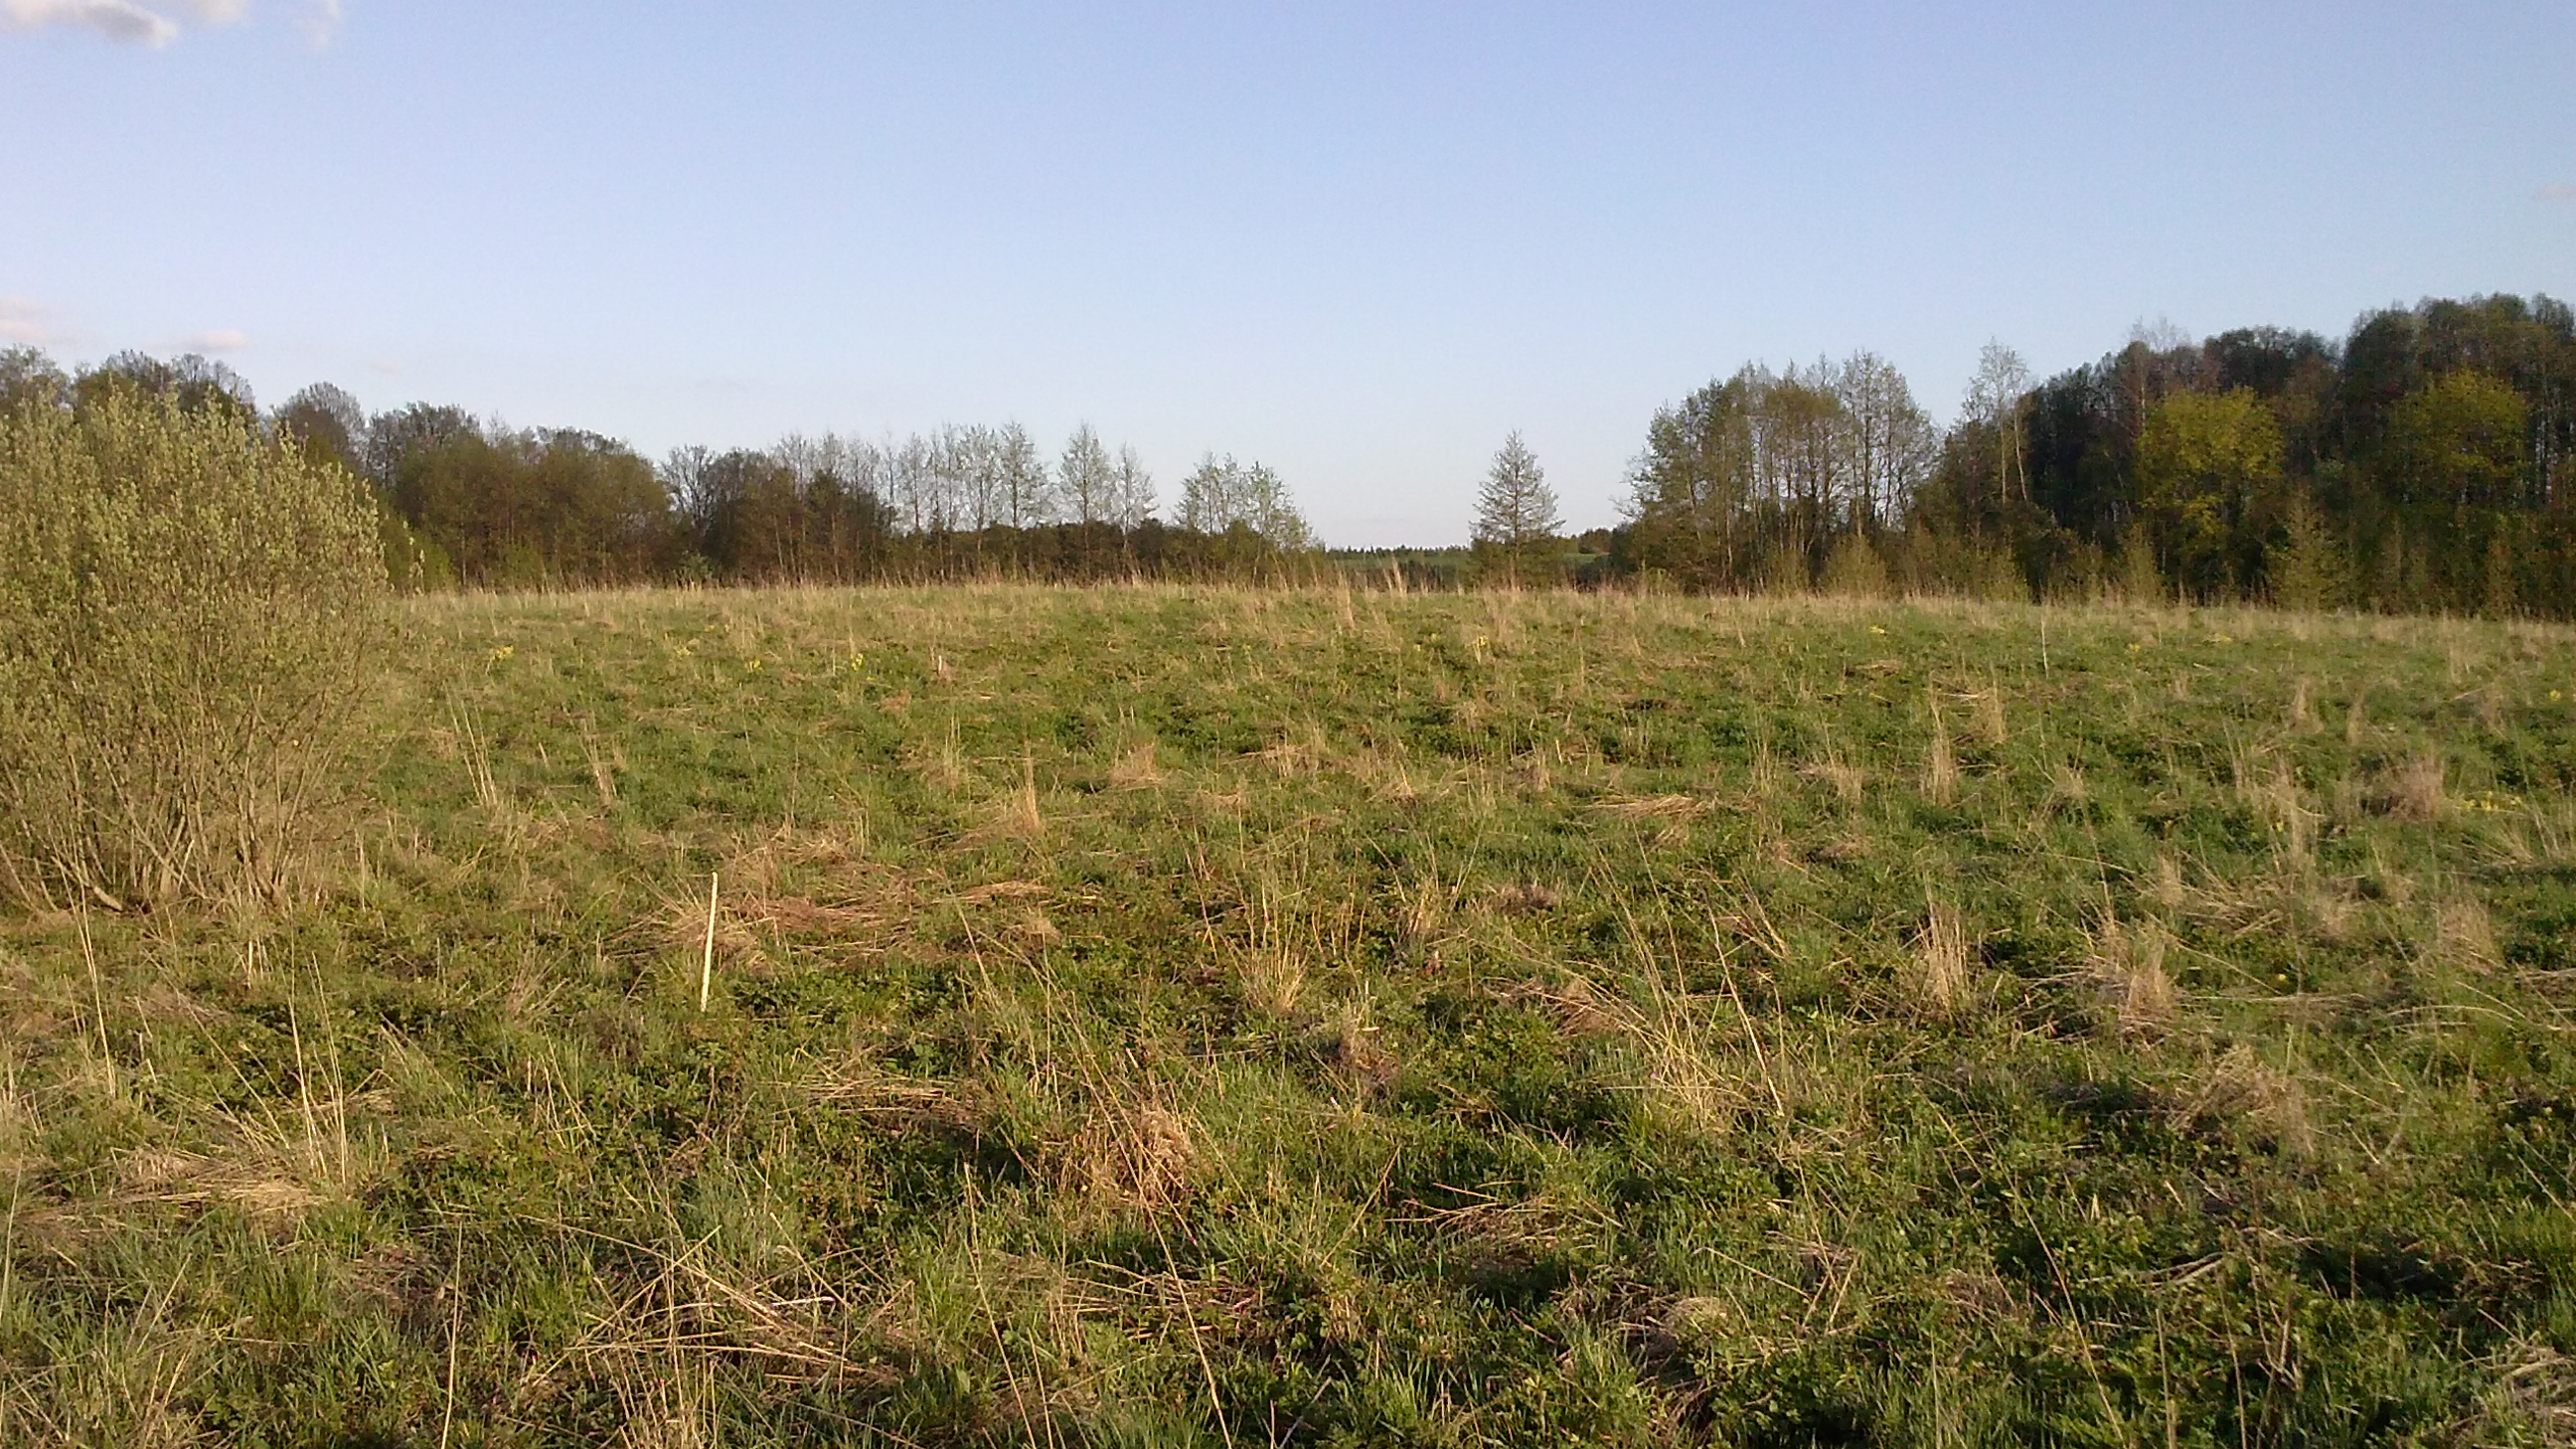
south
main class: Grassland
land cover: Grassland without tree/shrub cover
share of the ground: > 75 %
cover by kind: herbaceous plants 100 %
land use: Agriculture (excluding fallow land and kitchen gardens)
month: May
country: LV
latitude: 56.1142
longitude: 27.2357
